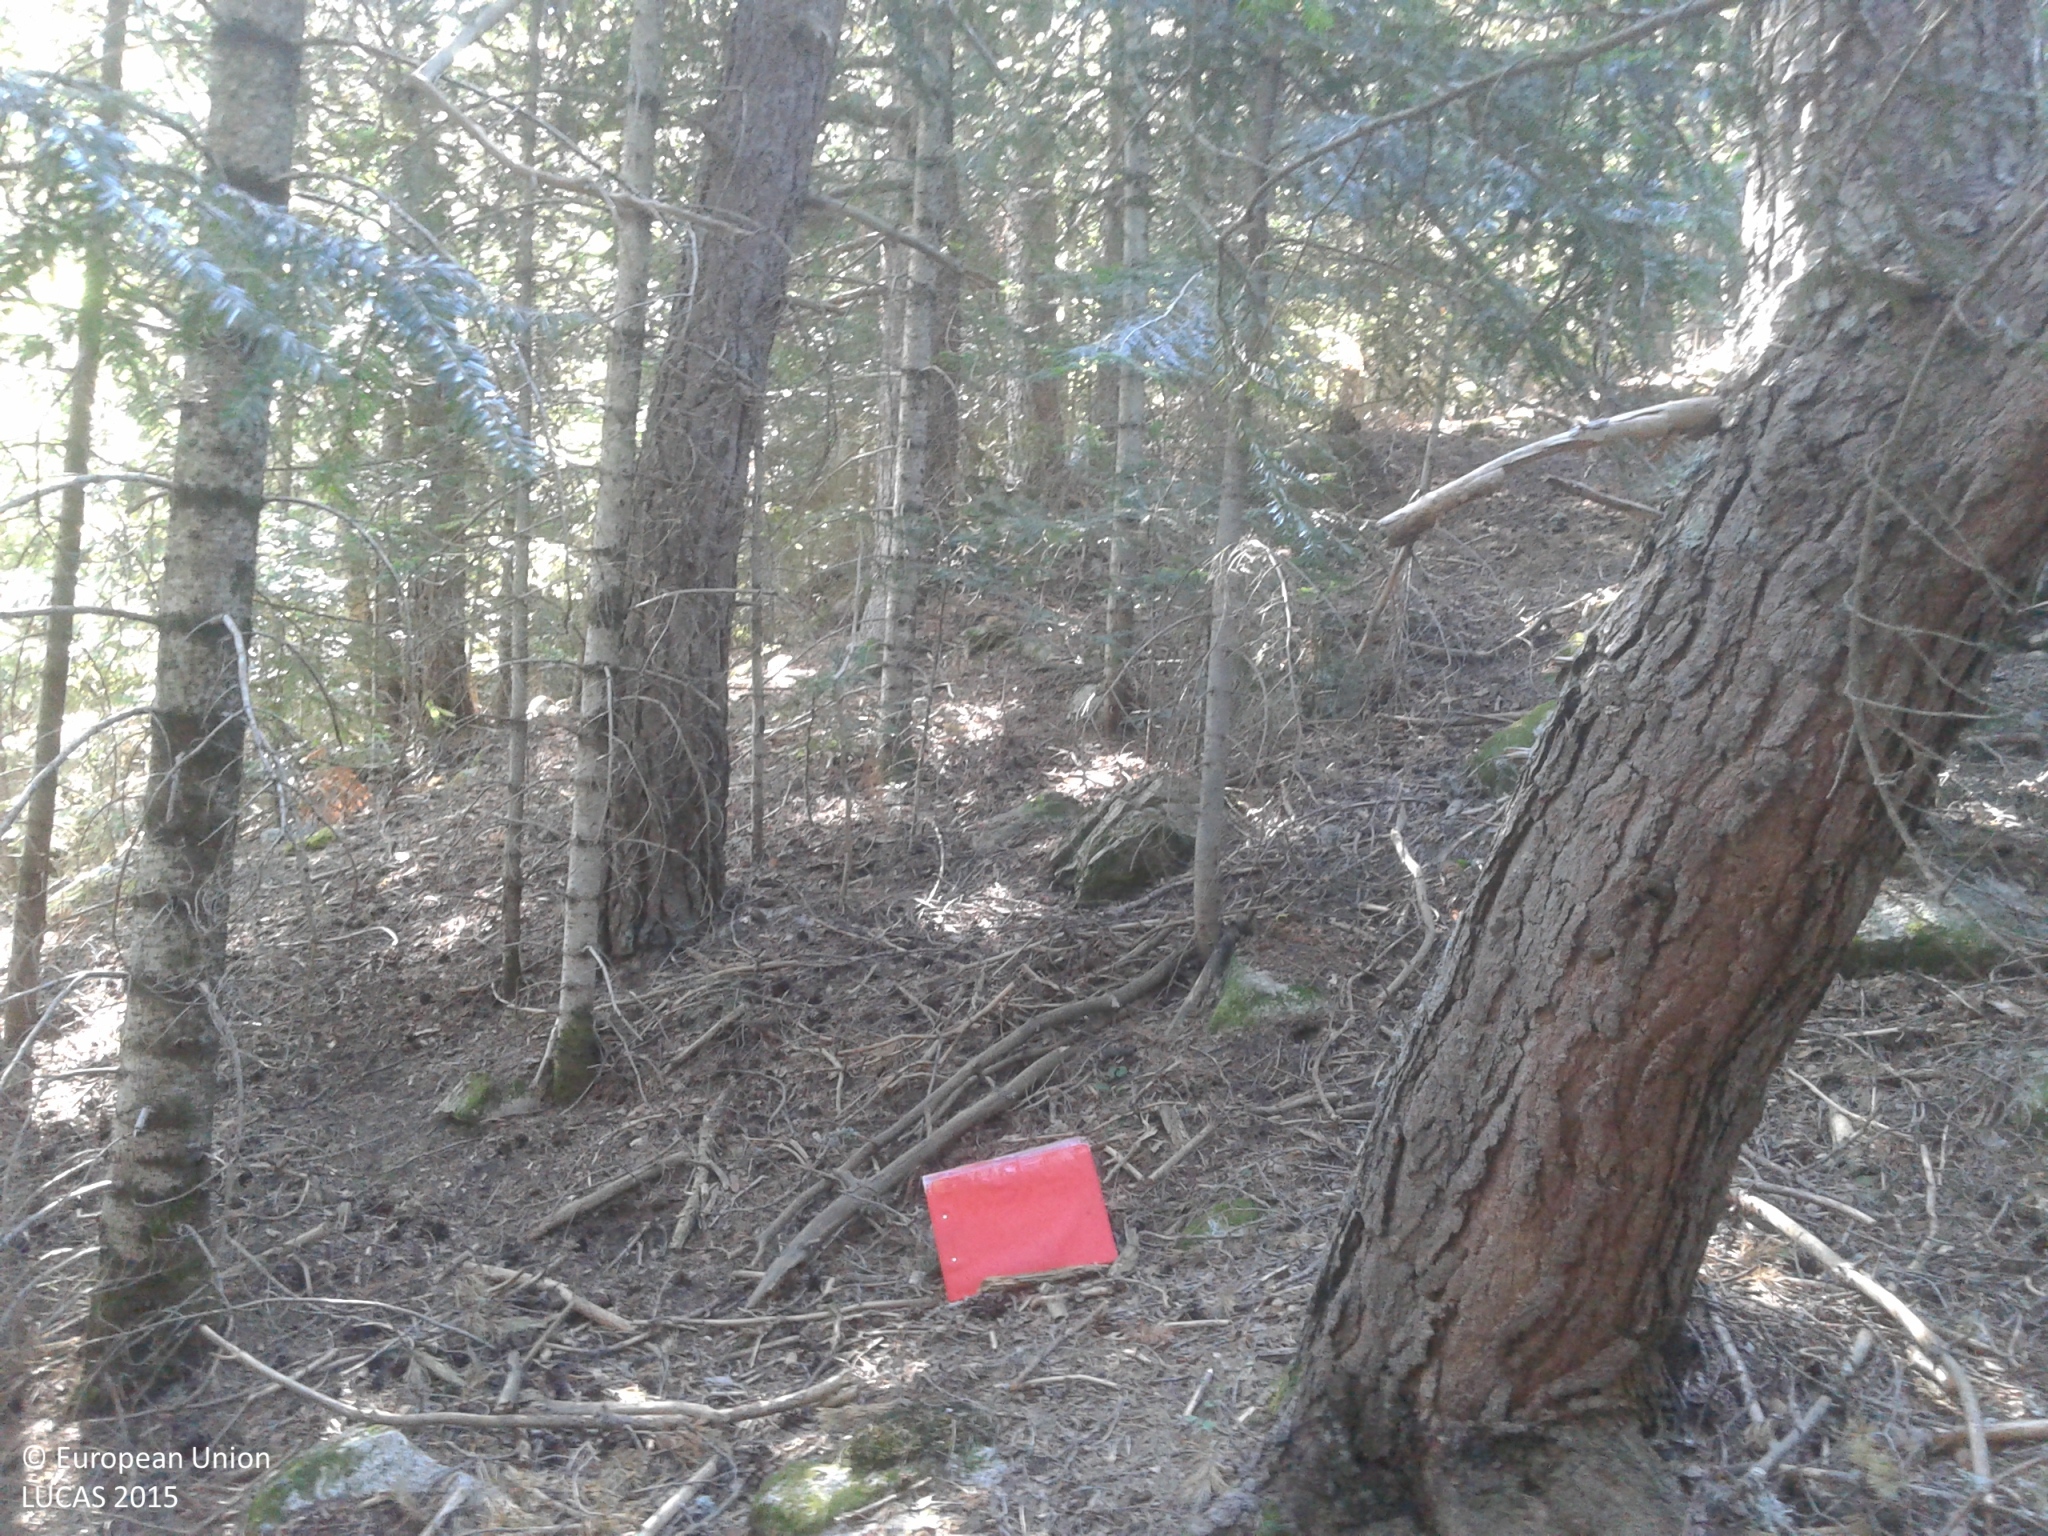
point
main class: Woodland
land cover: Pine dominated coniferous woodland
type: alpine coniferous forest
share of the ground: > 75 %
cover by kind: coniferous forest trees 90 %, broadleaved forest trees 5 %, herbaceous plants 5 %
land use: Semi-natural and natural areas not in use
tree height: > 5 m
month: July
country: ES
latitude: 42.5819
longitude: 1.0269
